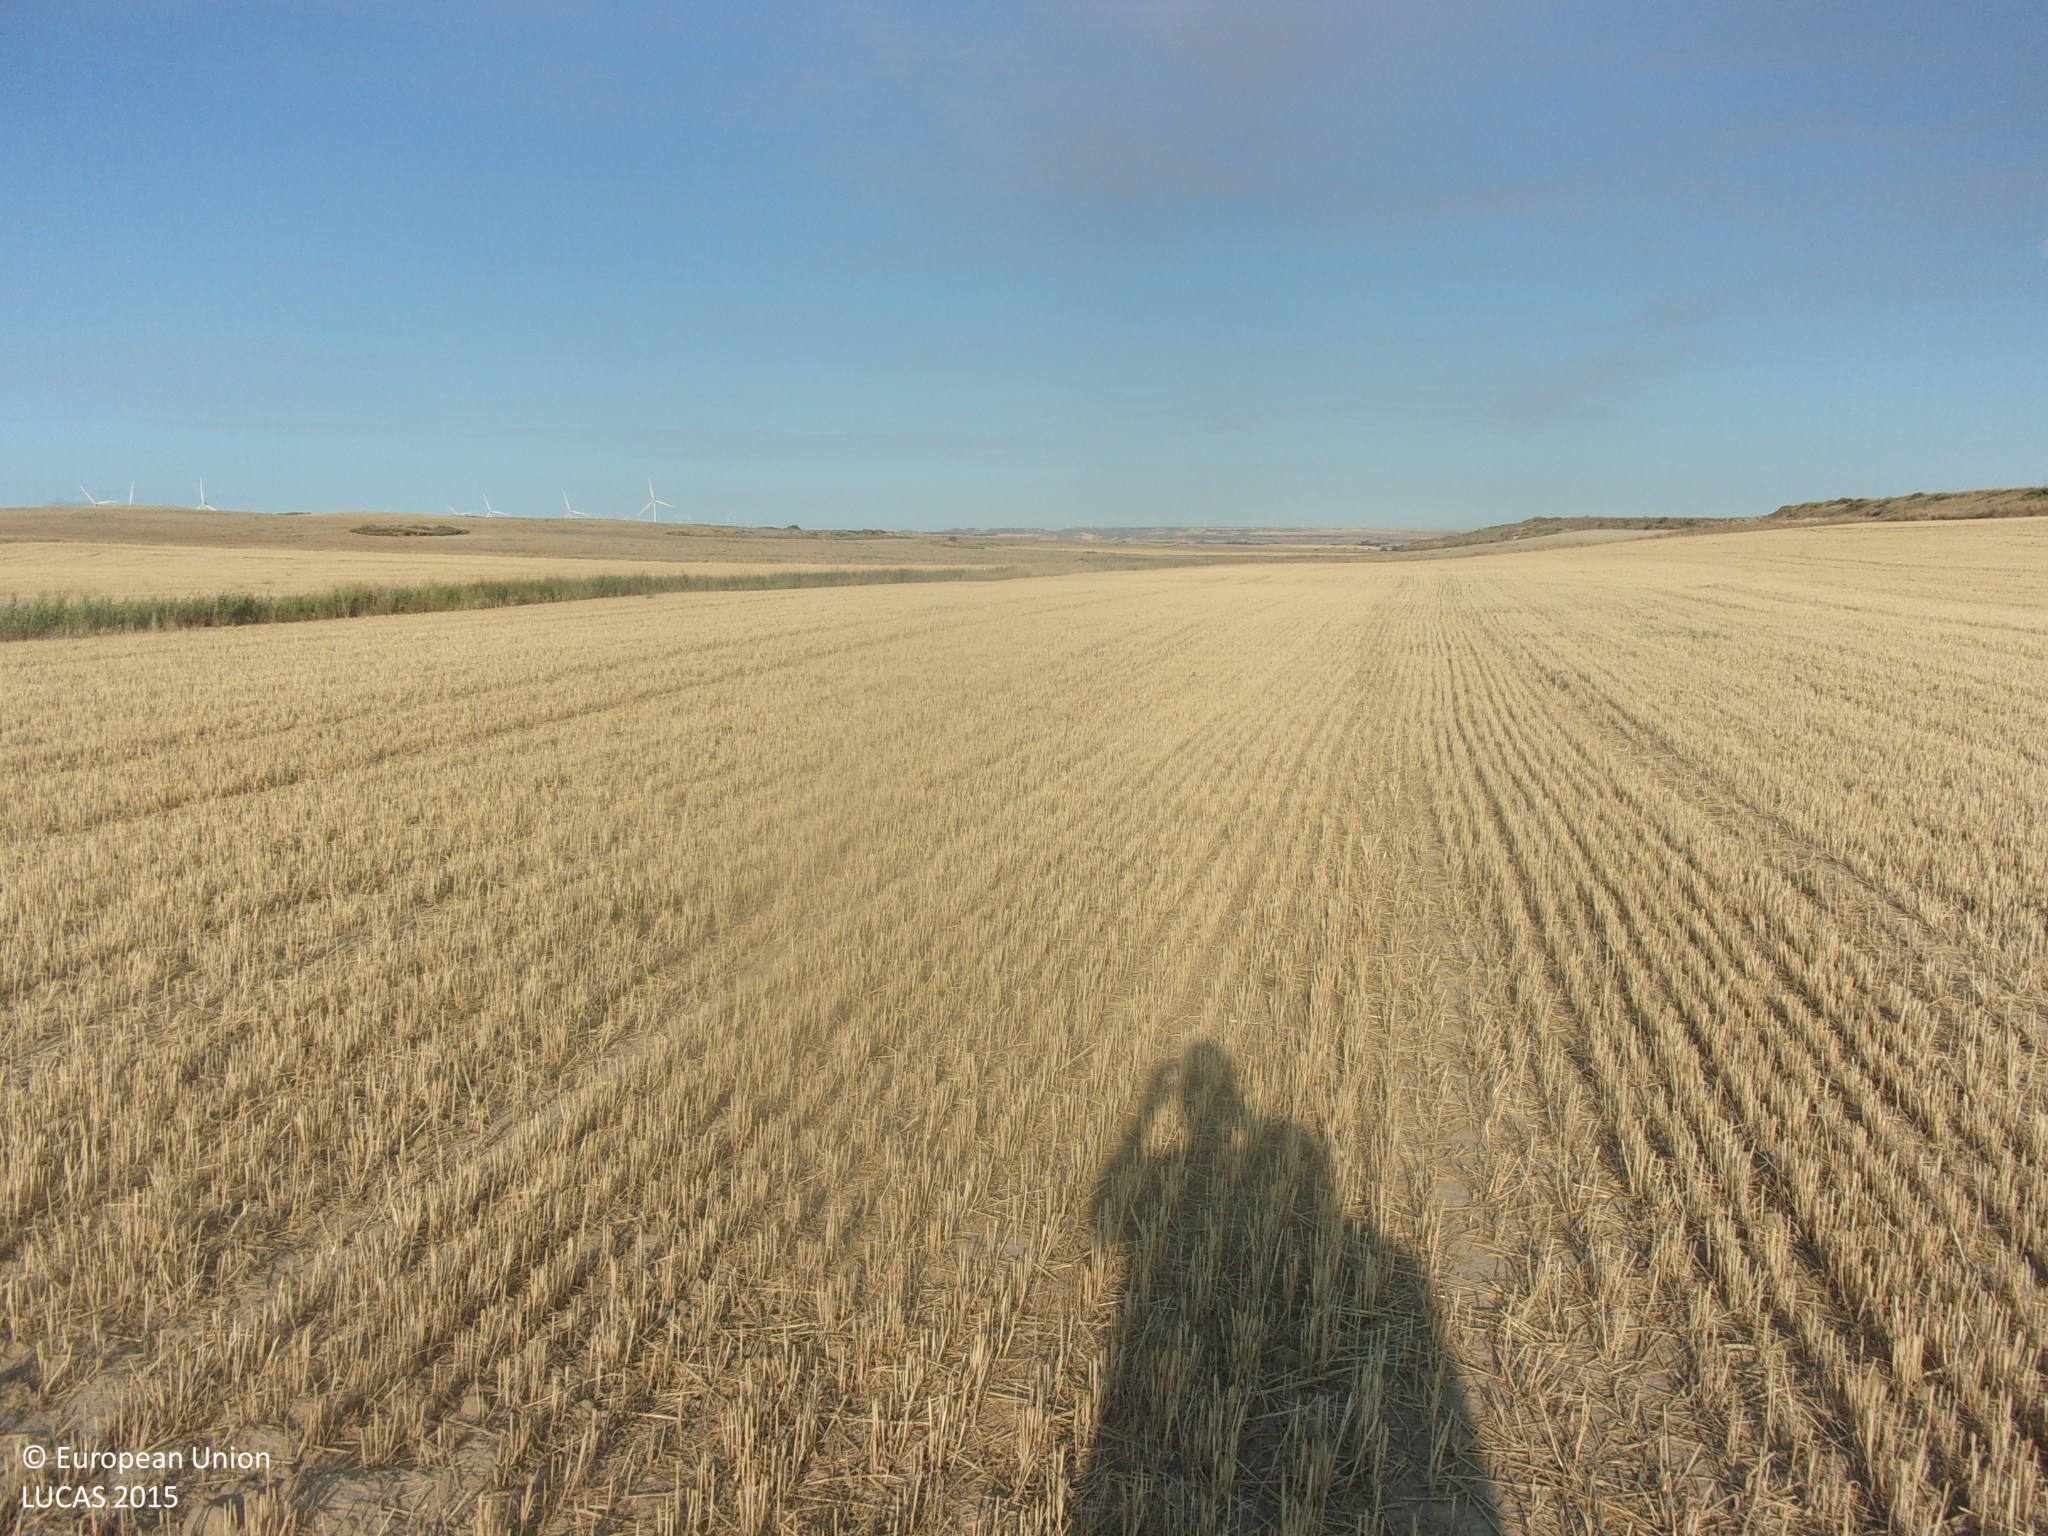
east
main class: Cropland
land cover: Barley
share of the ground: < 10 %
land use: Agriculture (excluding fallow land and kitchen gardens)
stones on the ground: < 10 %
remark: Harvested field
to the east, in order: Barley; Grass margins; Ditches and canals; Grass margins; Barley; Grass margins; Other bare soil
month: July
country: ES
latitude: 42.0677
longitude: -0.8662
